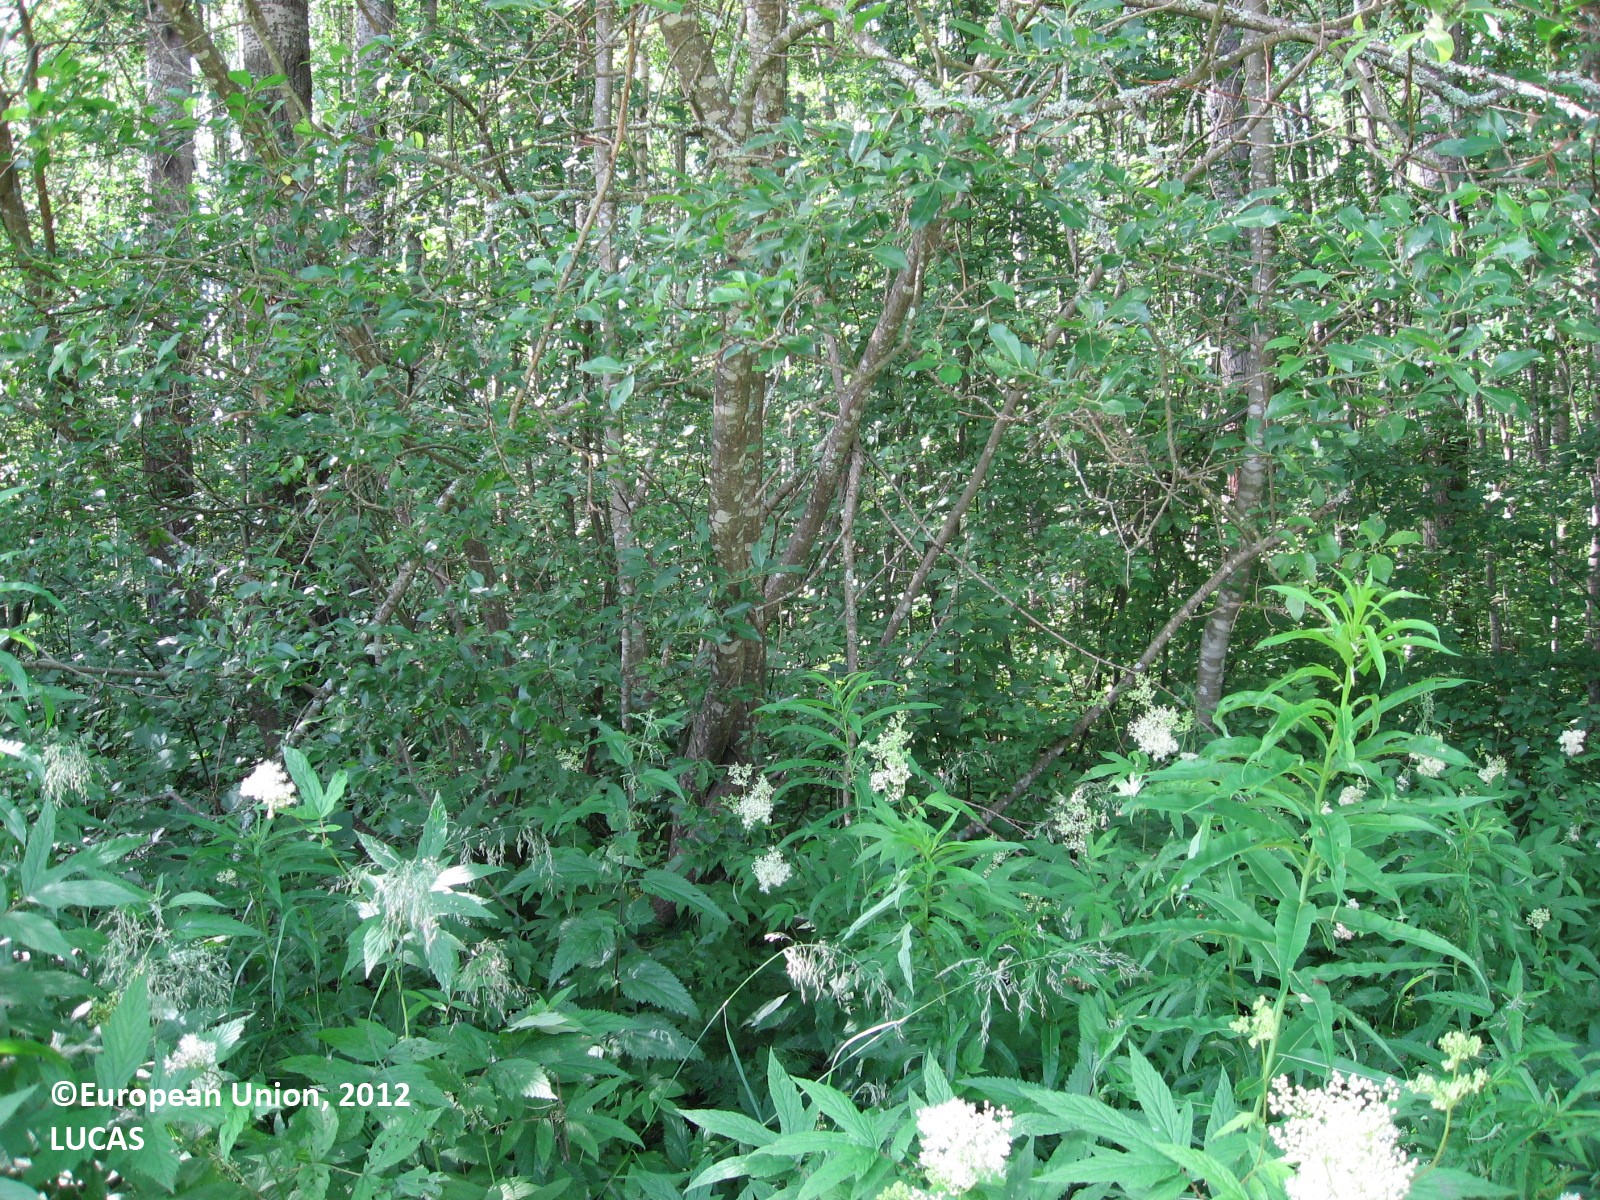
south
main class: Shrubland
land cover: Shrubland with sparse tree cover
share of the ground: > 75 %
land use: Semi-natural and natural areas not in use
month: July
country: FI
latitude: 61.1382
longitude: 25.6729
